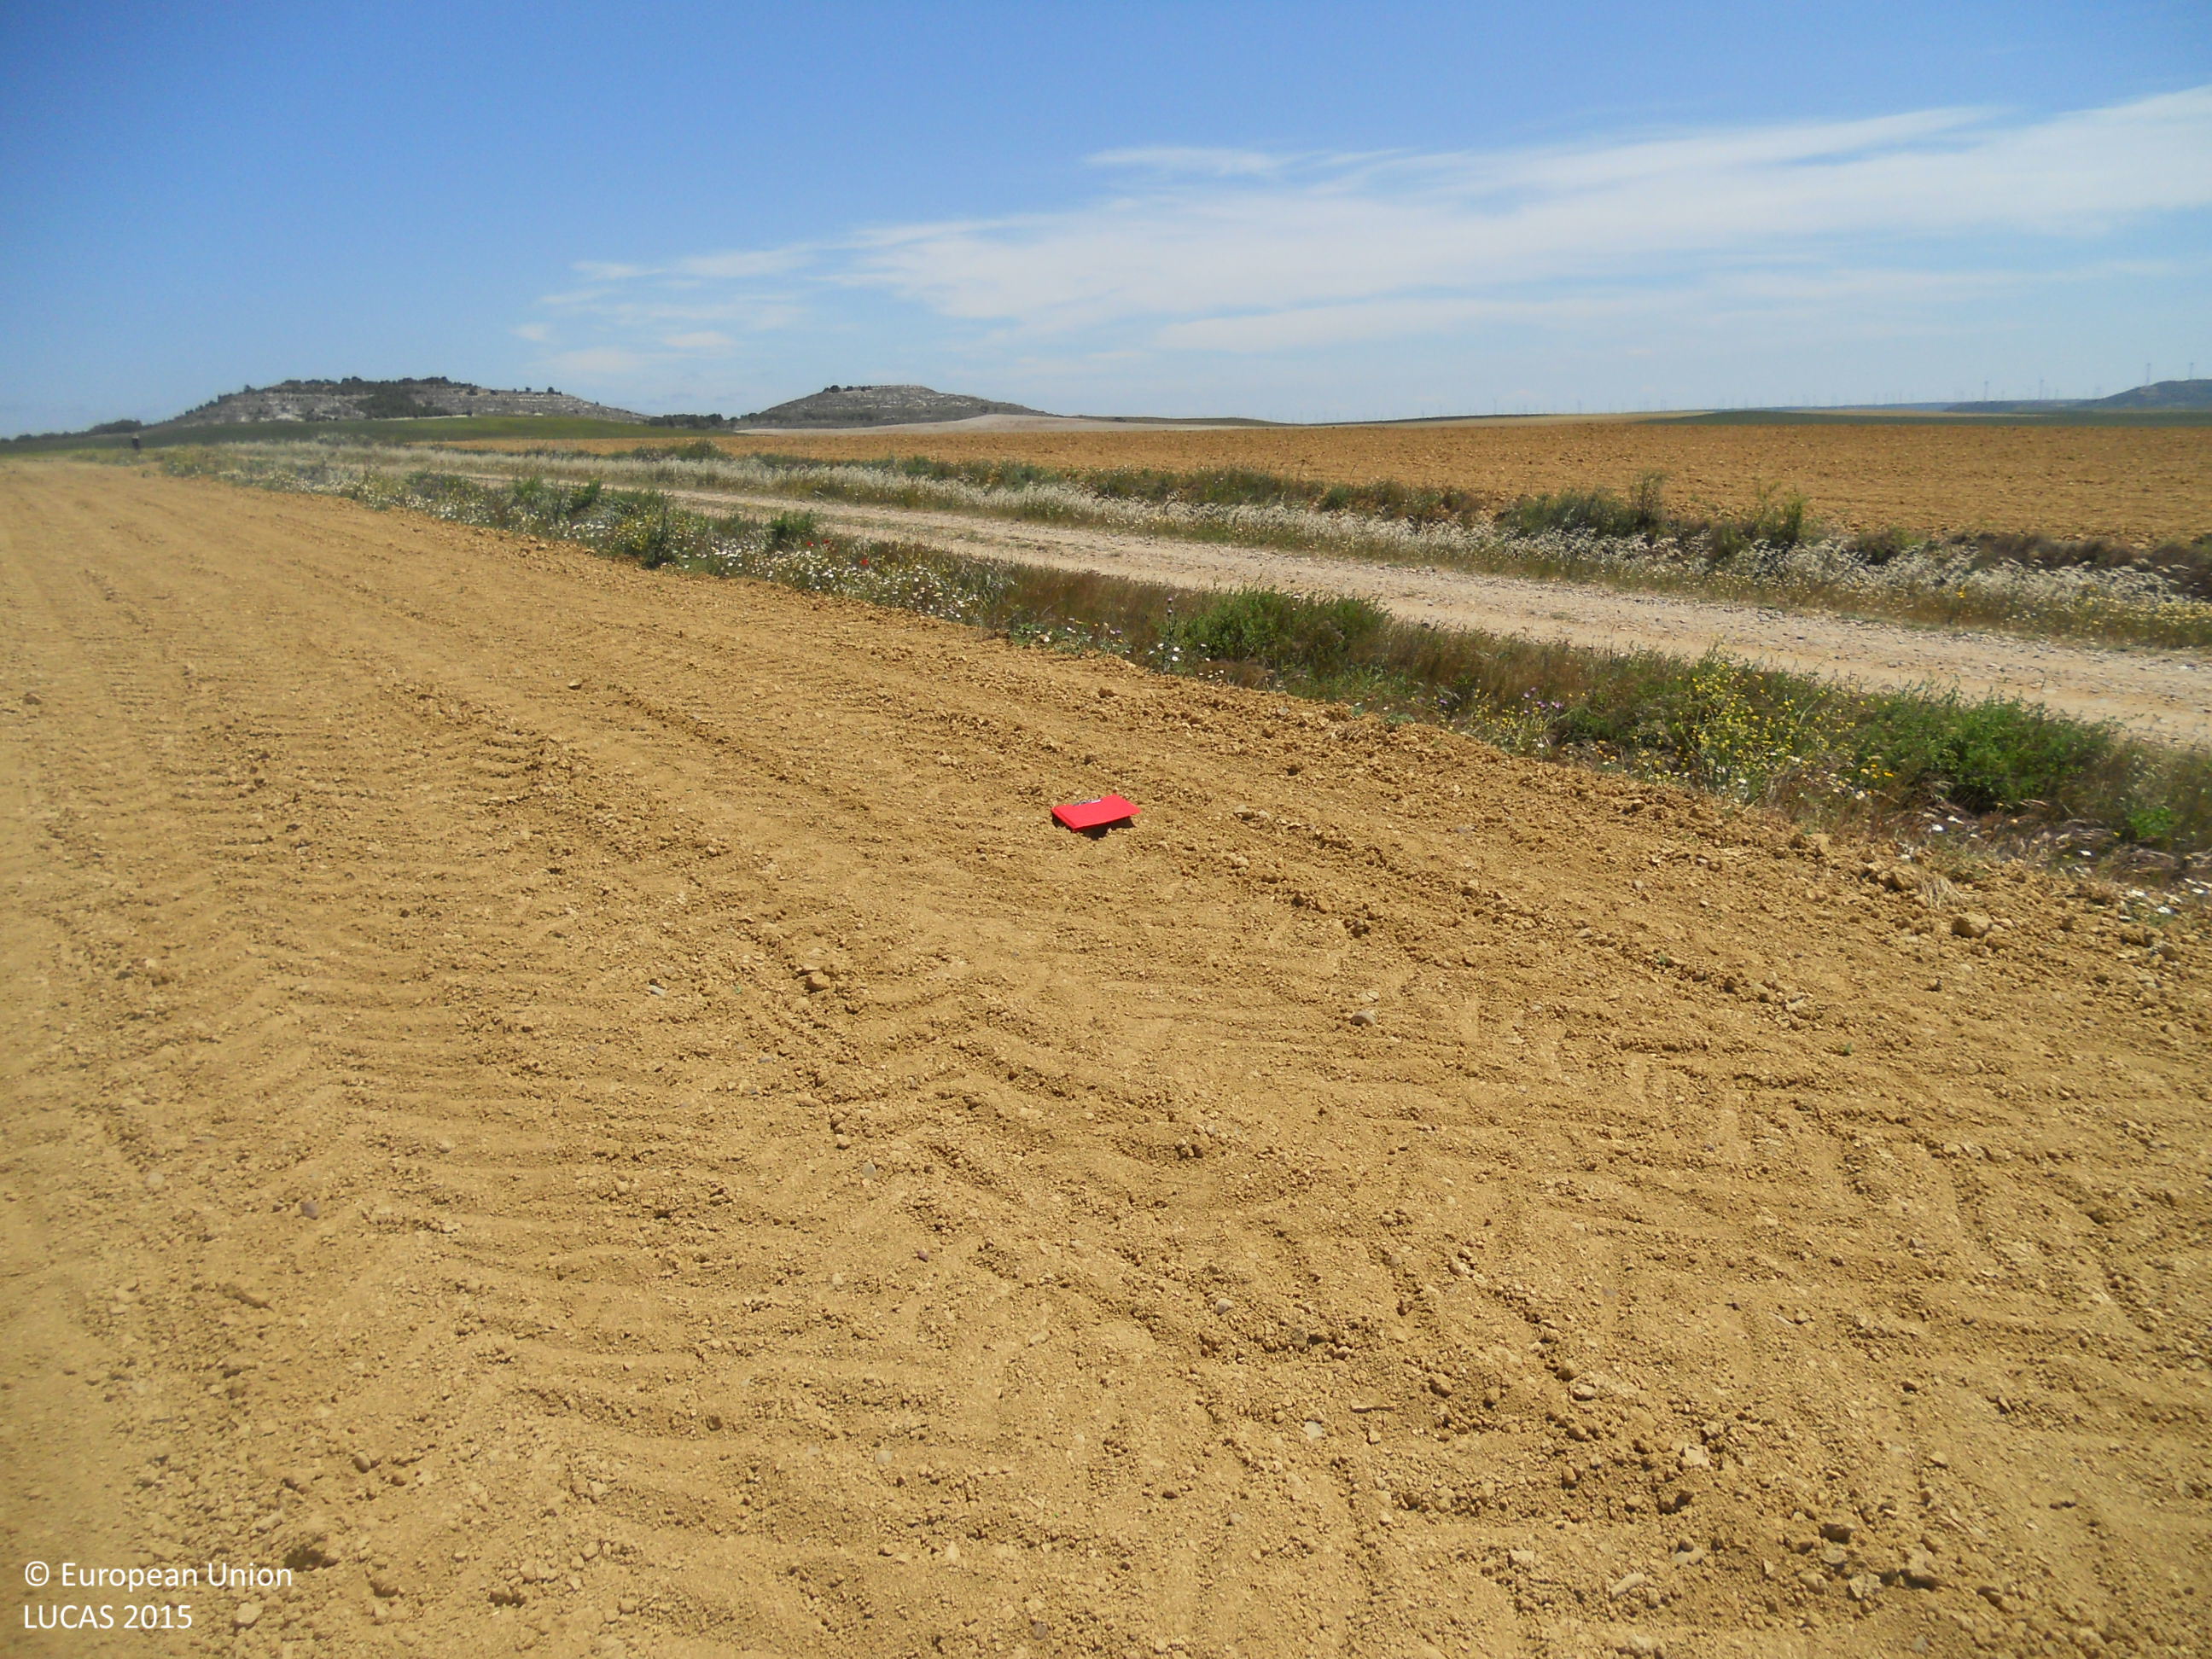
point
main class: Cropland
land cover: Sunflower
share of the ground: < 10 %
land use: Agriculture (excluding fallow land and kitchen gardens)
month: May
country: ES
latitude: 42.2720
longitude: -4.3160
